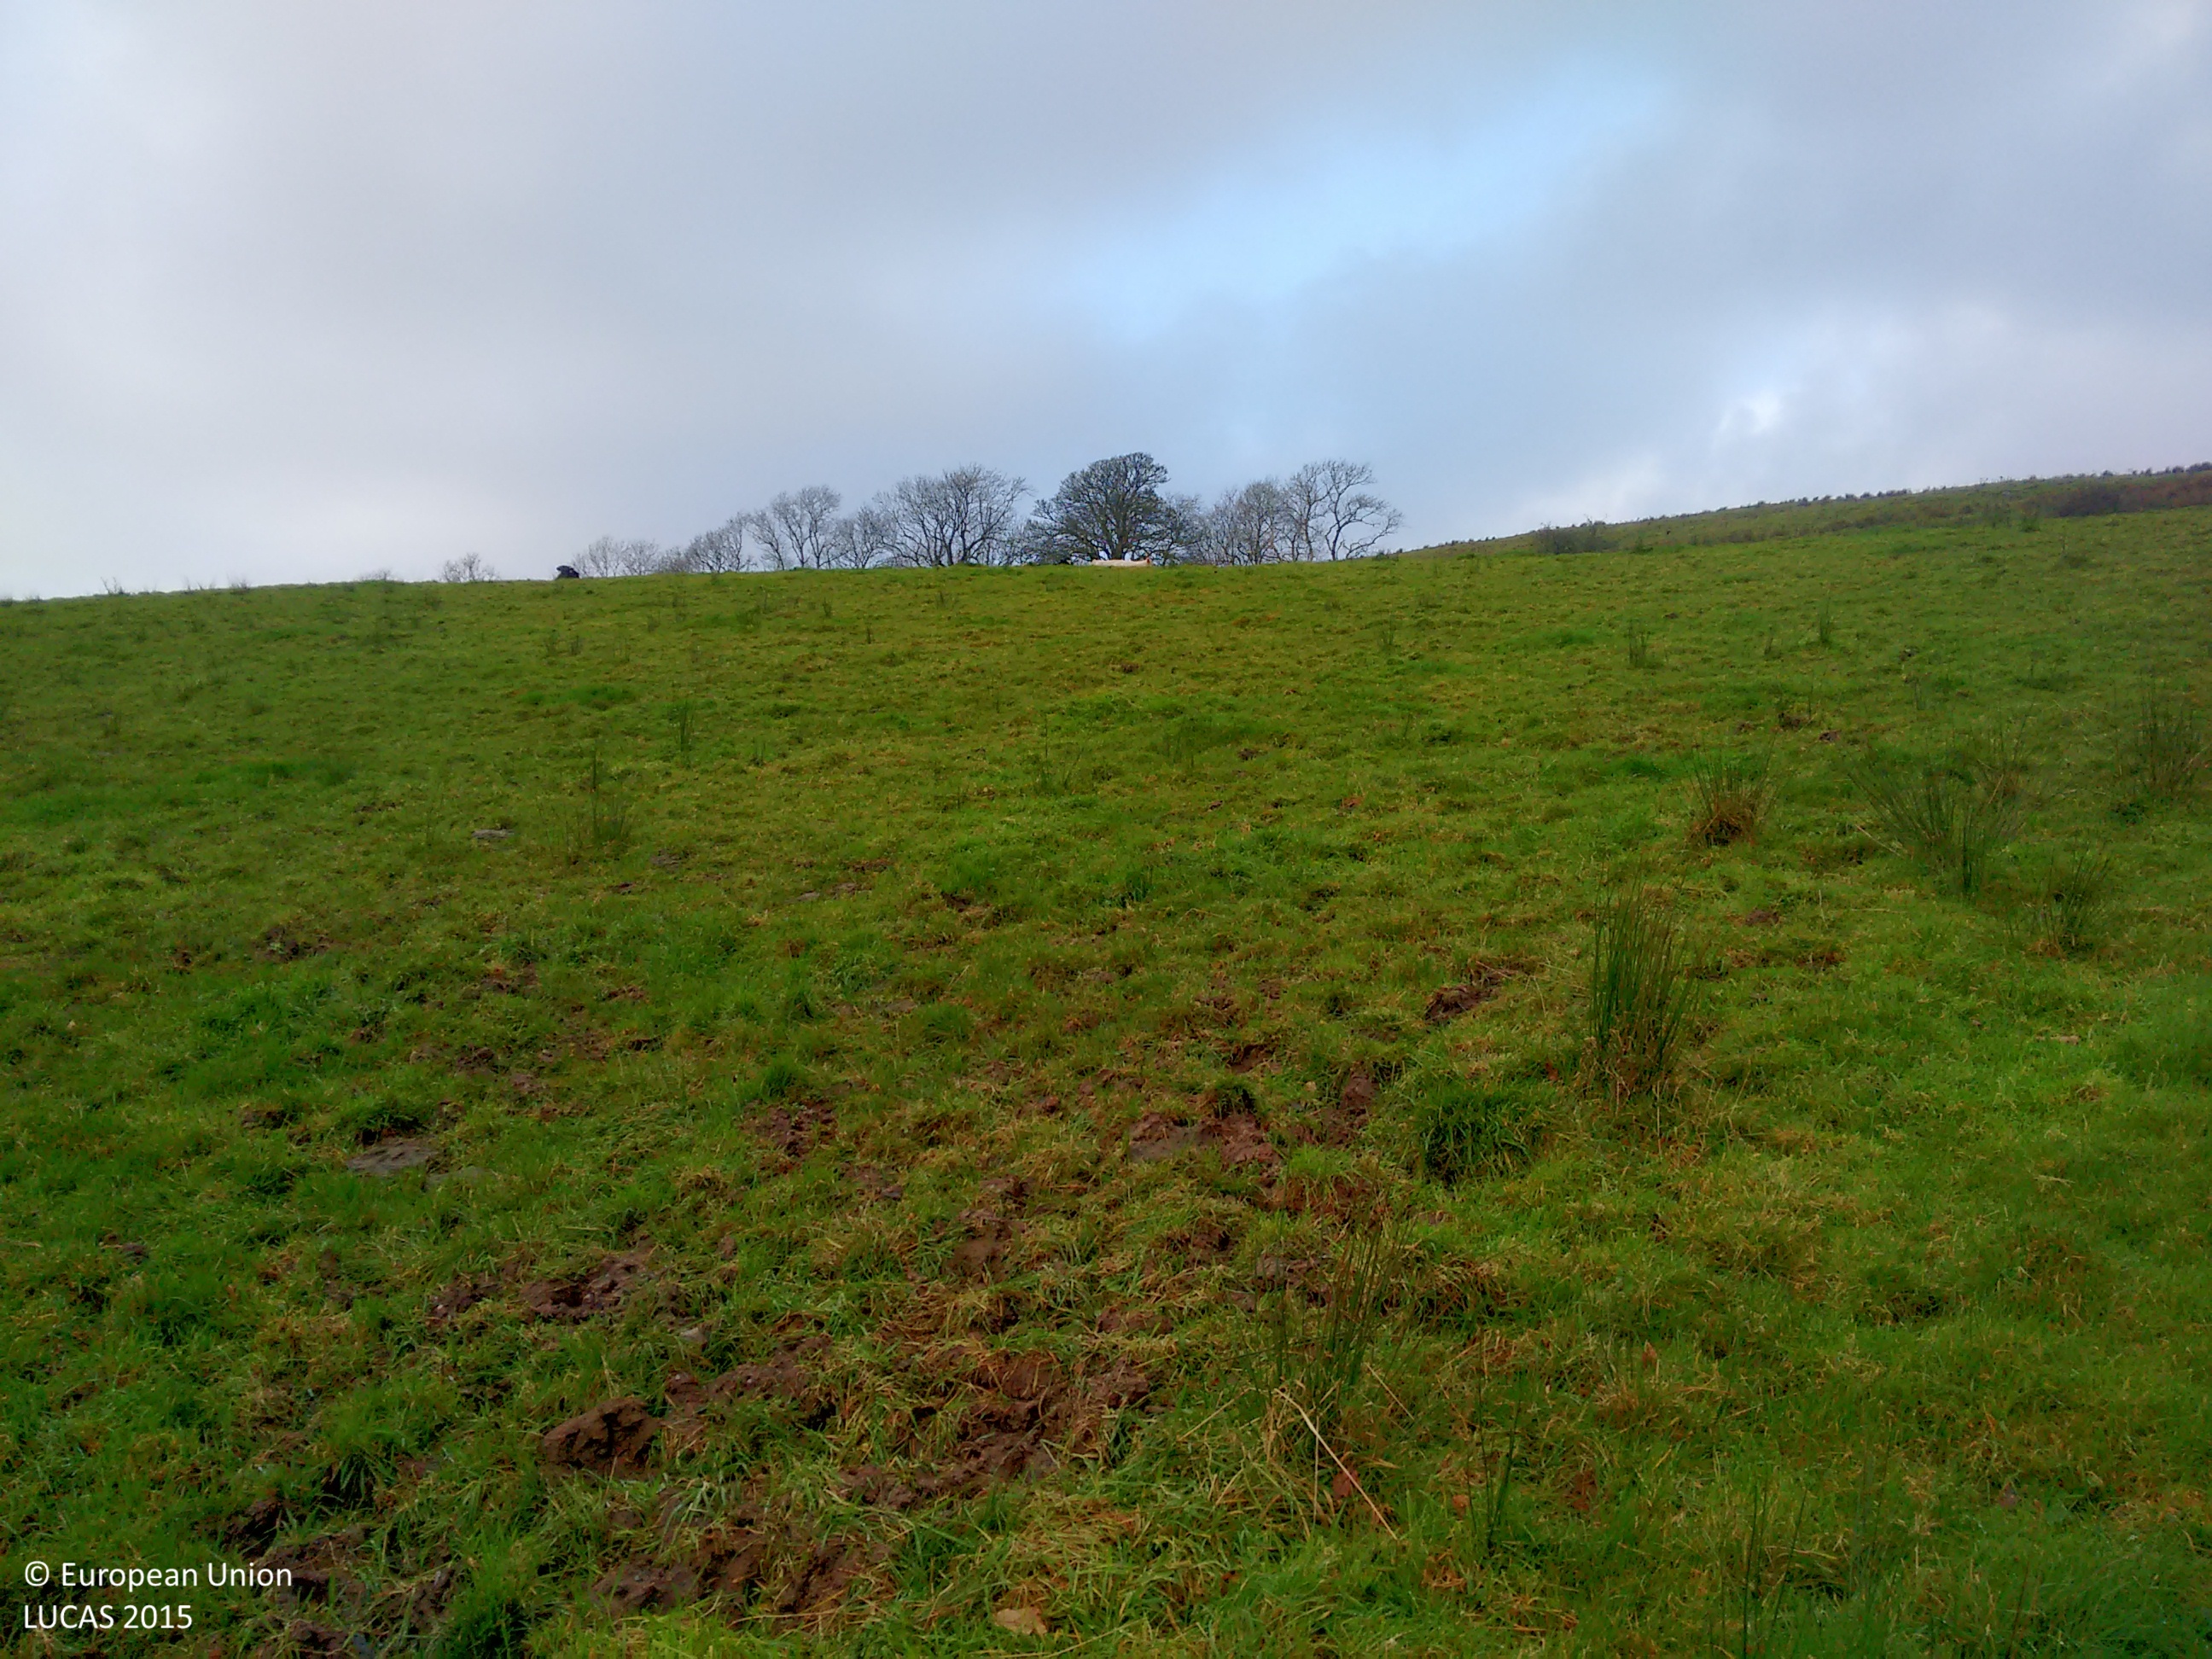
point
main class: Grassland
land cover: Grassland without tree/shrub cover
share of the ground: > 75 %
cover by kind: herbaceous plants 100 %
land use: Agriculture (excluding fallow land and kitchen gardens)
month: November
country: IE
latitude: 54.2852
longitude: -8.3903
